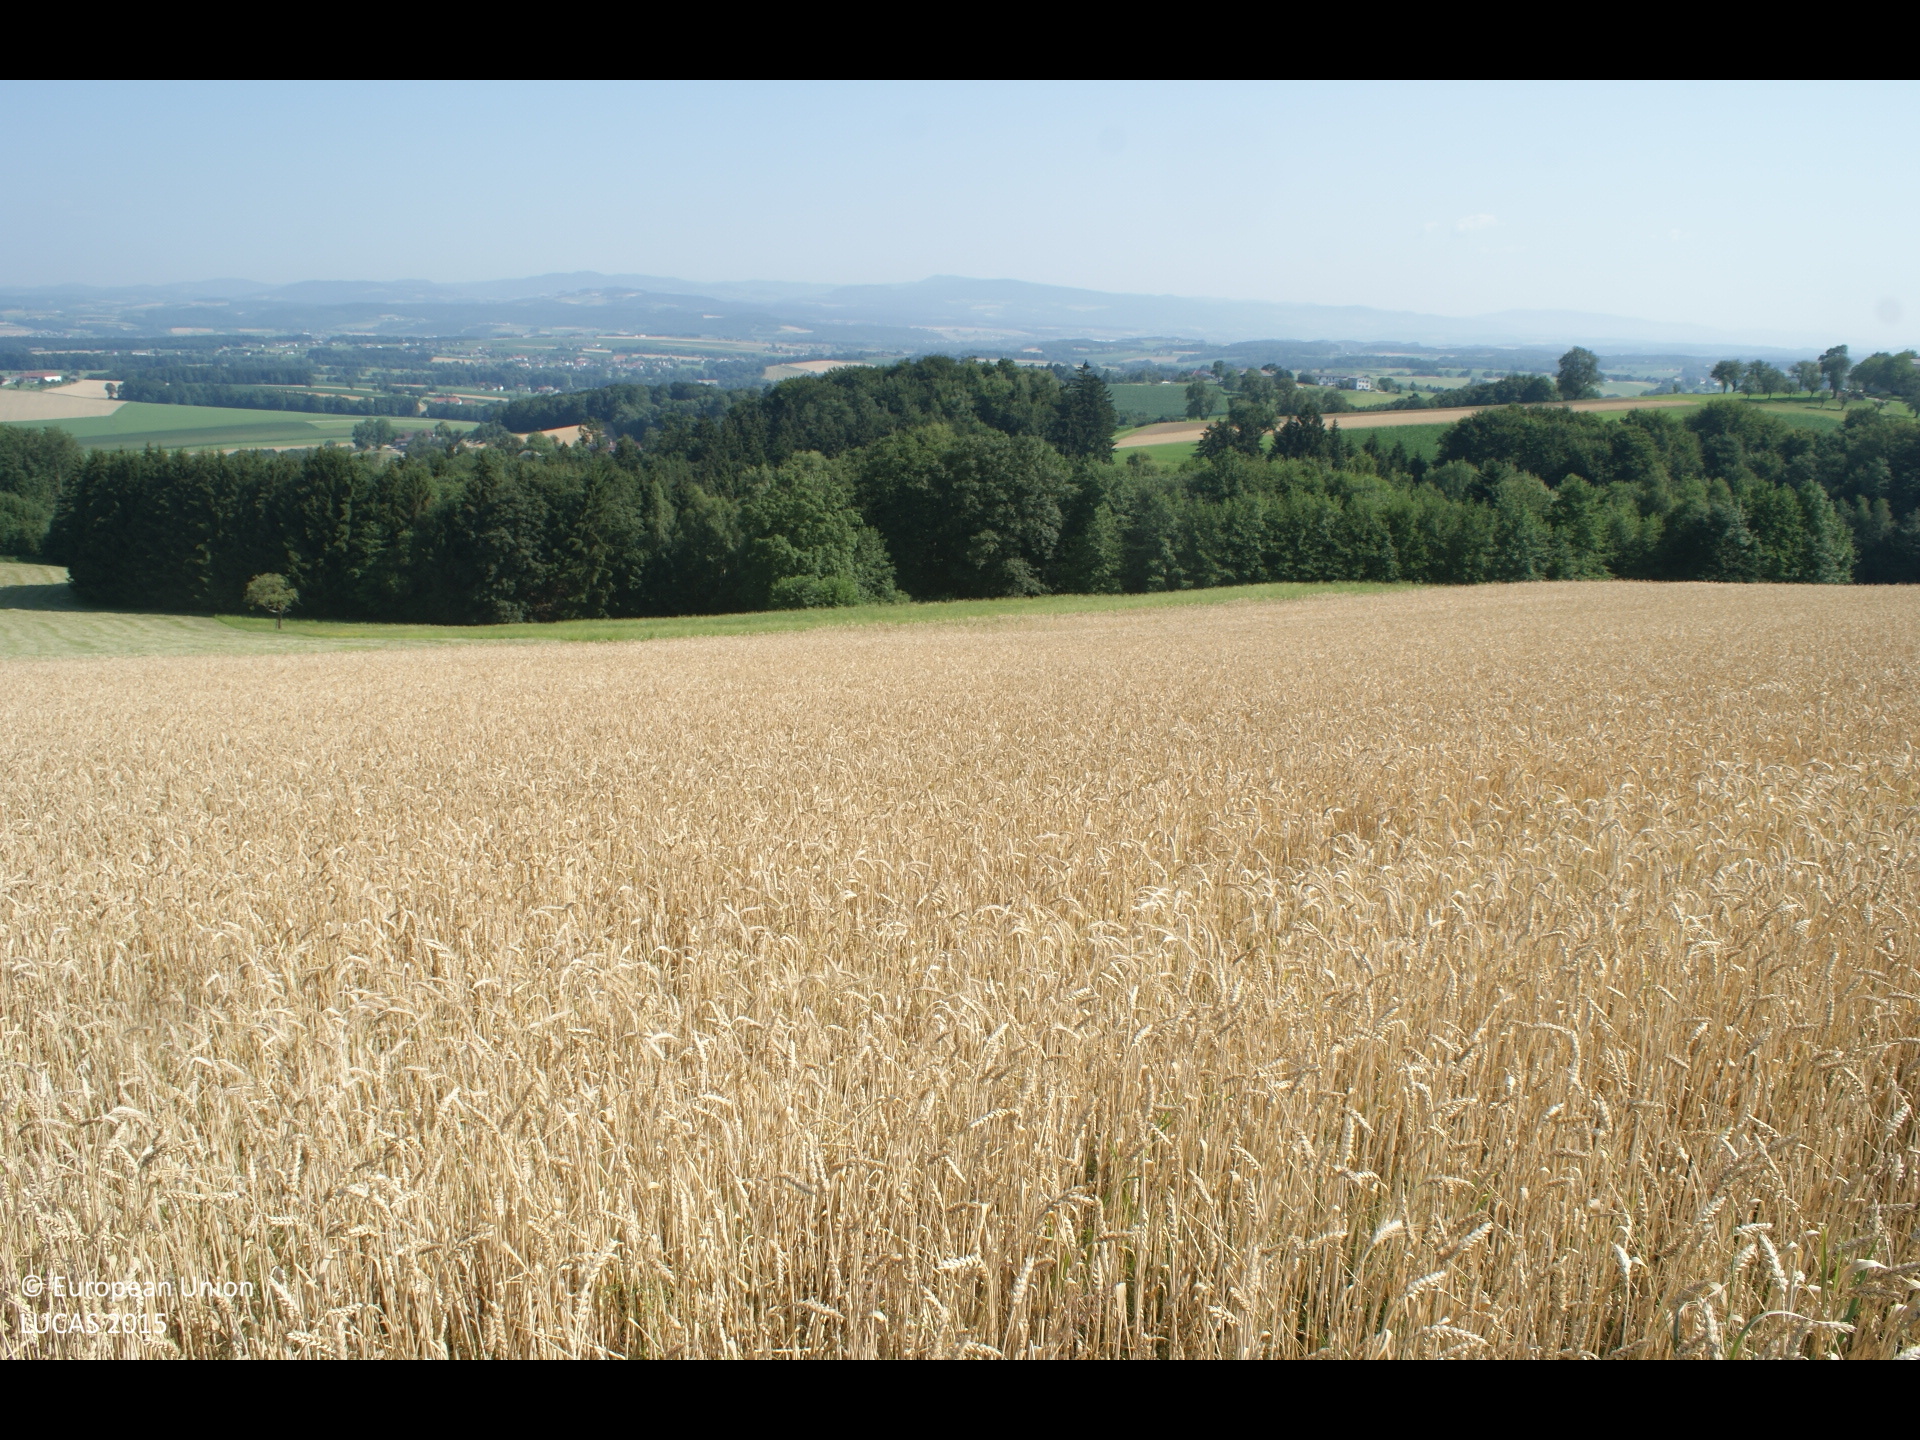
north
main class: Cropland
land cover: Common wheat
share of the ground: > 75 %
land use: Agriculture (excluding fallow land and kitchen gardens)
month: July
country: AT
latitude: 48.0570
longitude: 14.9787
